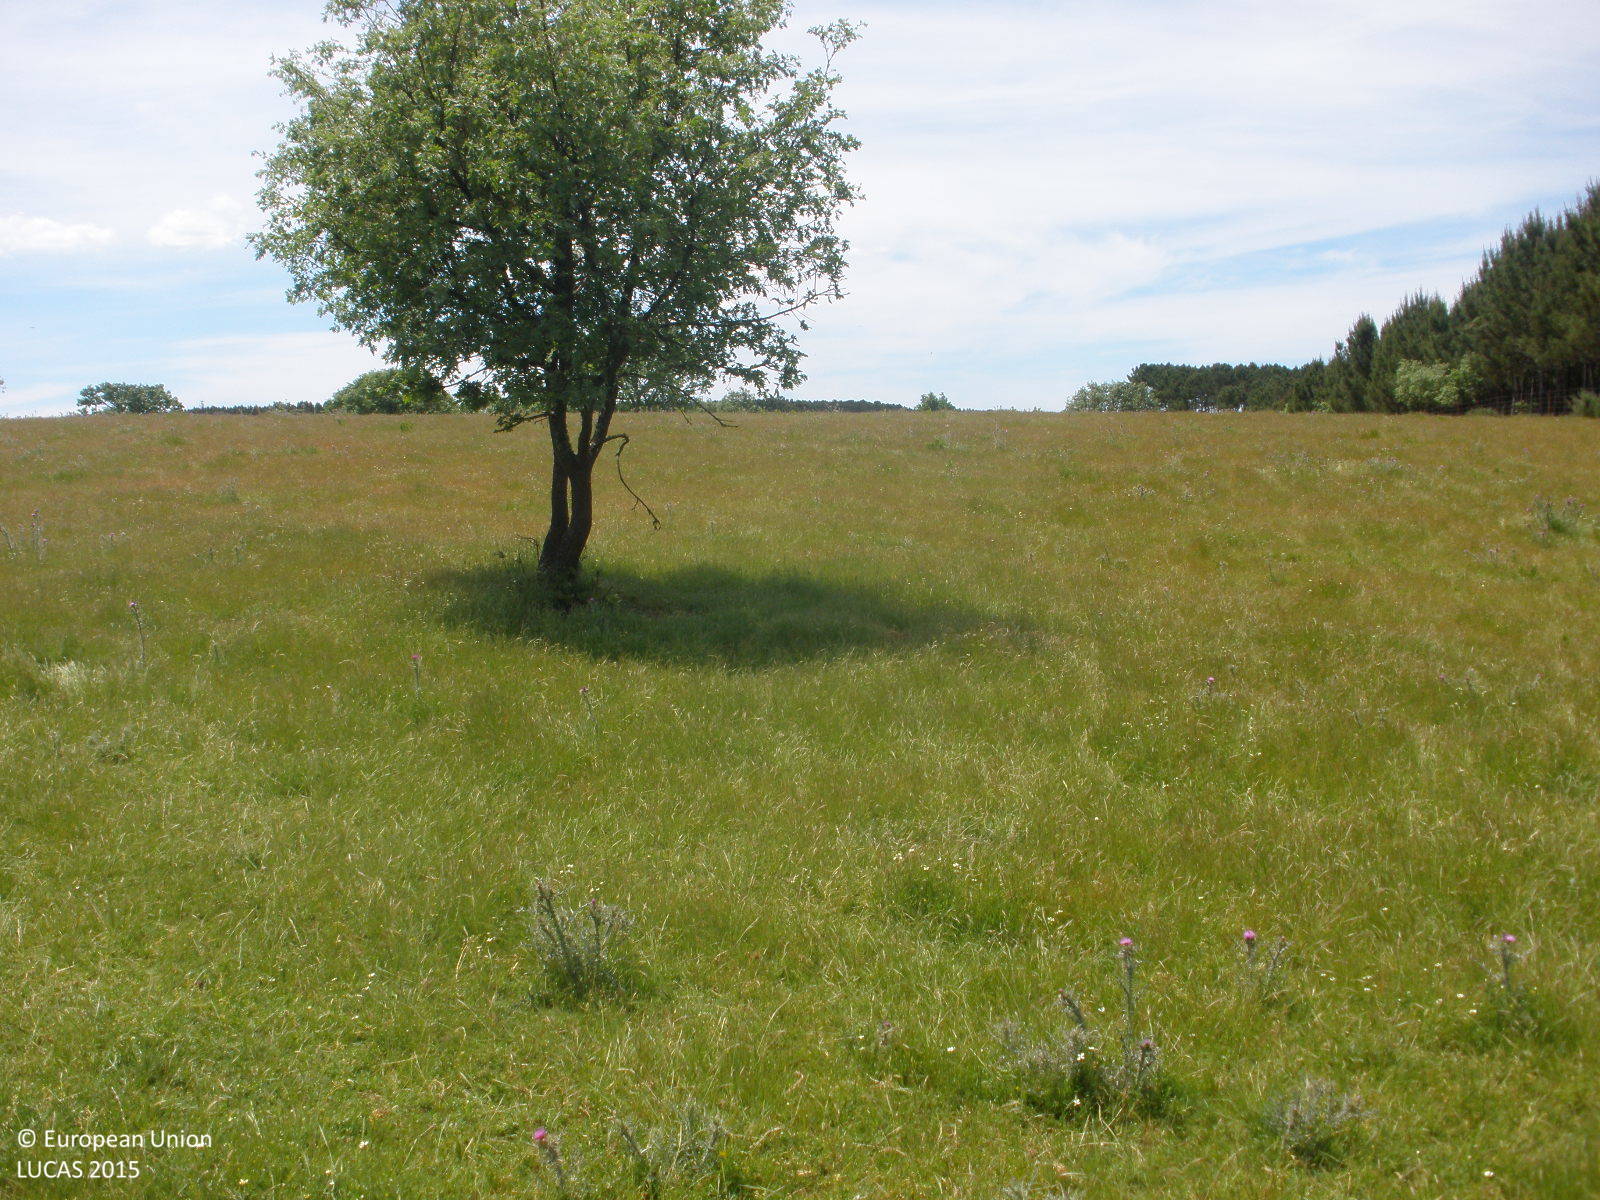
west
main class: Grassland
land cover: Grassland without tree/shrub cover
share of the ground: > 75 %
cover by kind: herbaceous plants 100 %
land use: Agriculture (excluding fallow land and kitchen gardens)
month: May
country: ES
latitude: 40.3691
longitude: -6.6109
